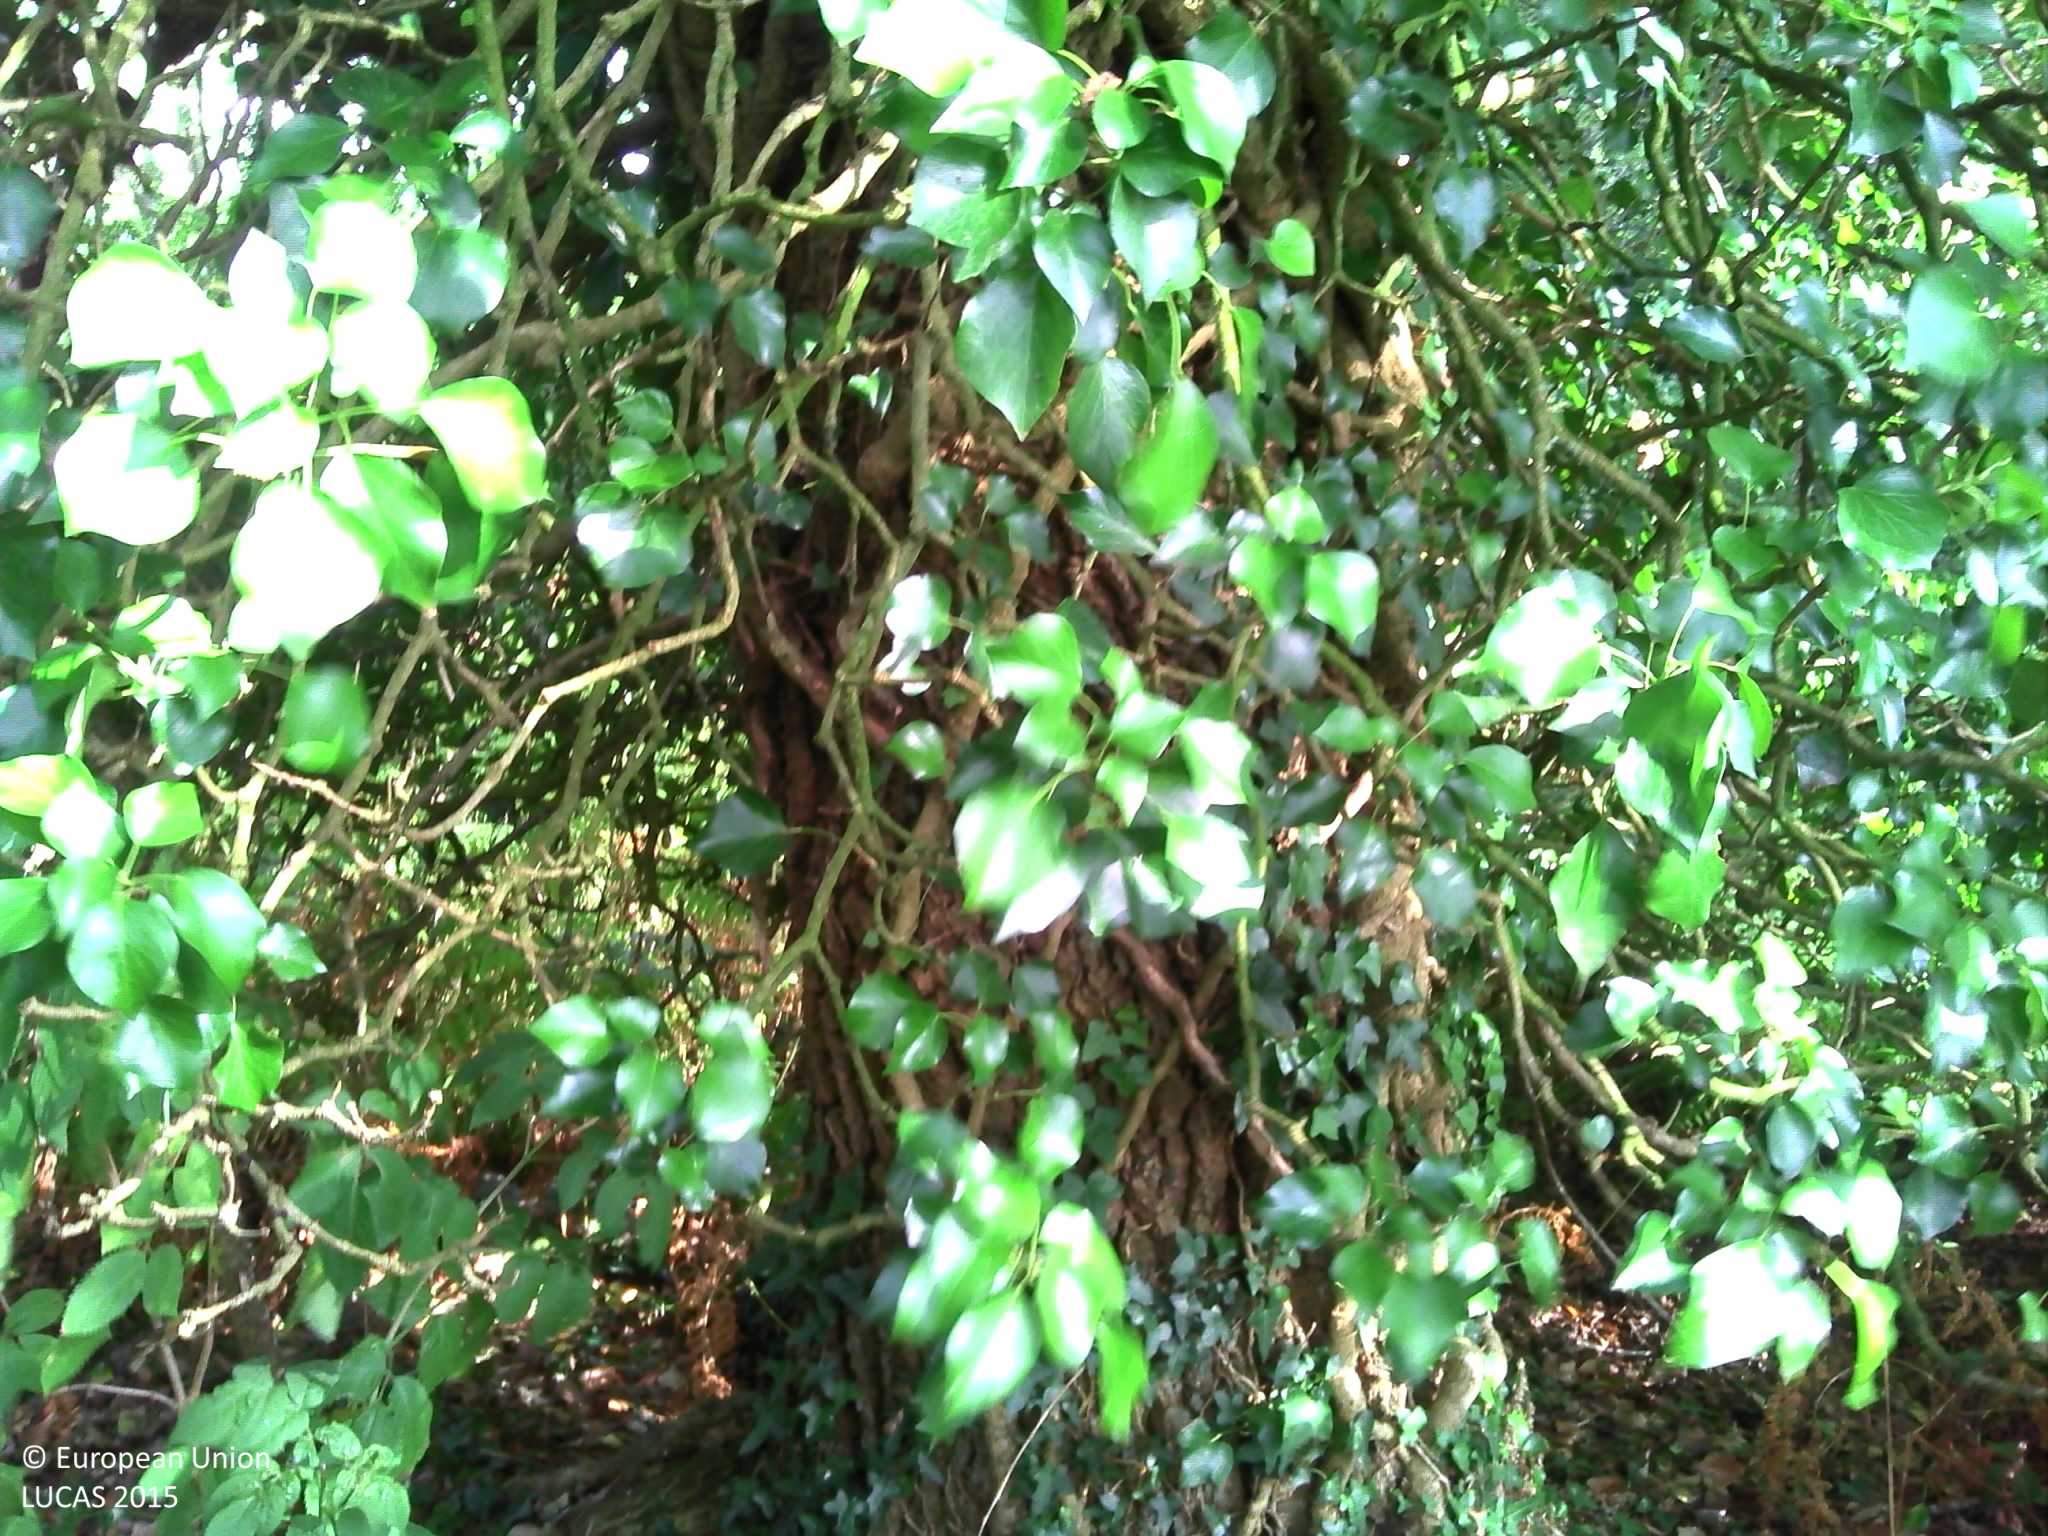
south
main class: Woodland
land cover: Broadleaved woodland
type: acidophilous oak and oak-birch forest
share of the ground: > 75 %
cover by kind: broadleaved forest trees 70 %, shrubs 10 %, herbaceous plants 10 %, consolidated bare surface 10 %
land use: Forestry
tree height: > 5 m
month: July
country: FR
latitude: 47.7942
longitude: -3.4646
